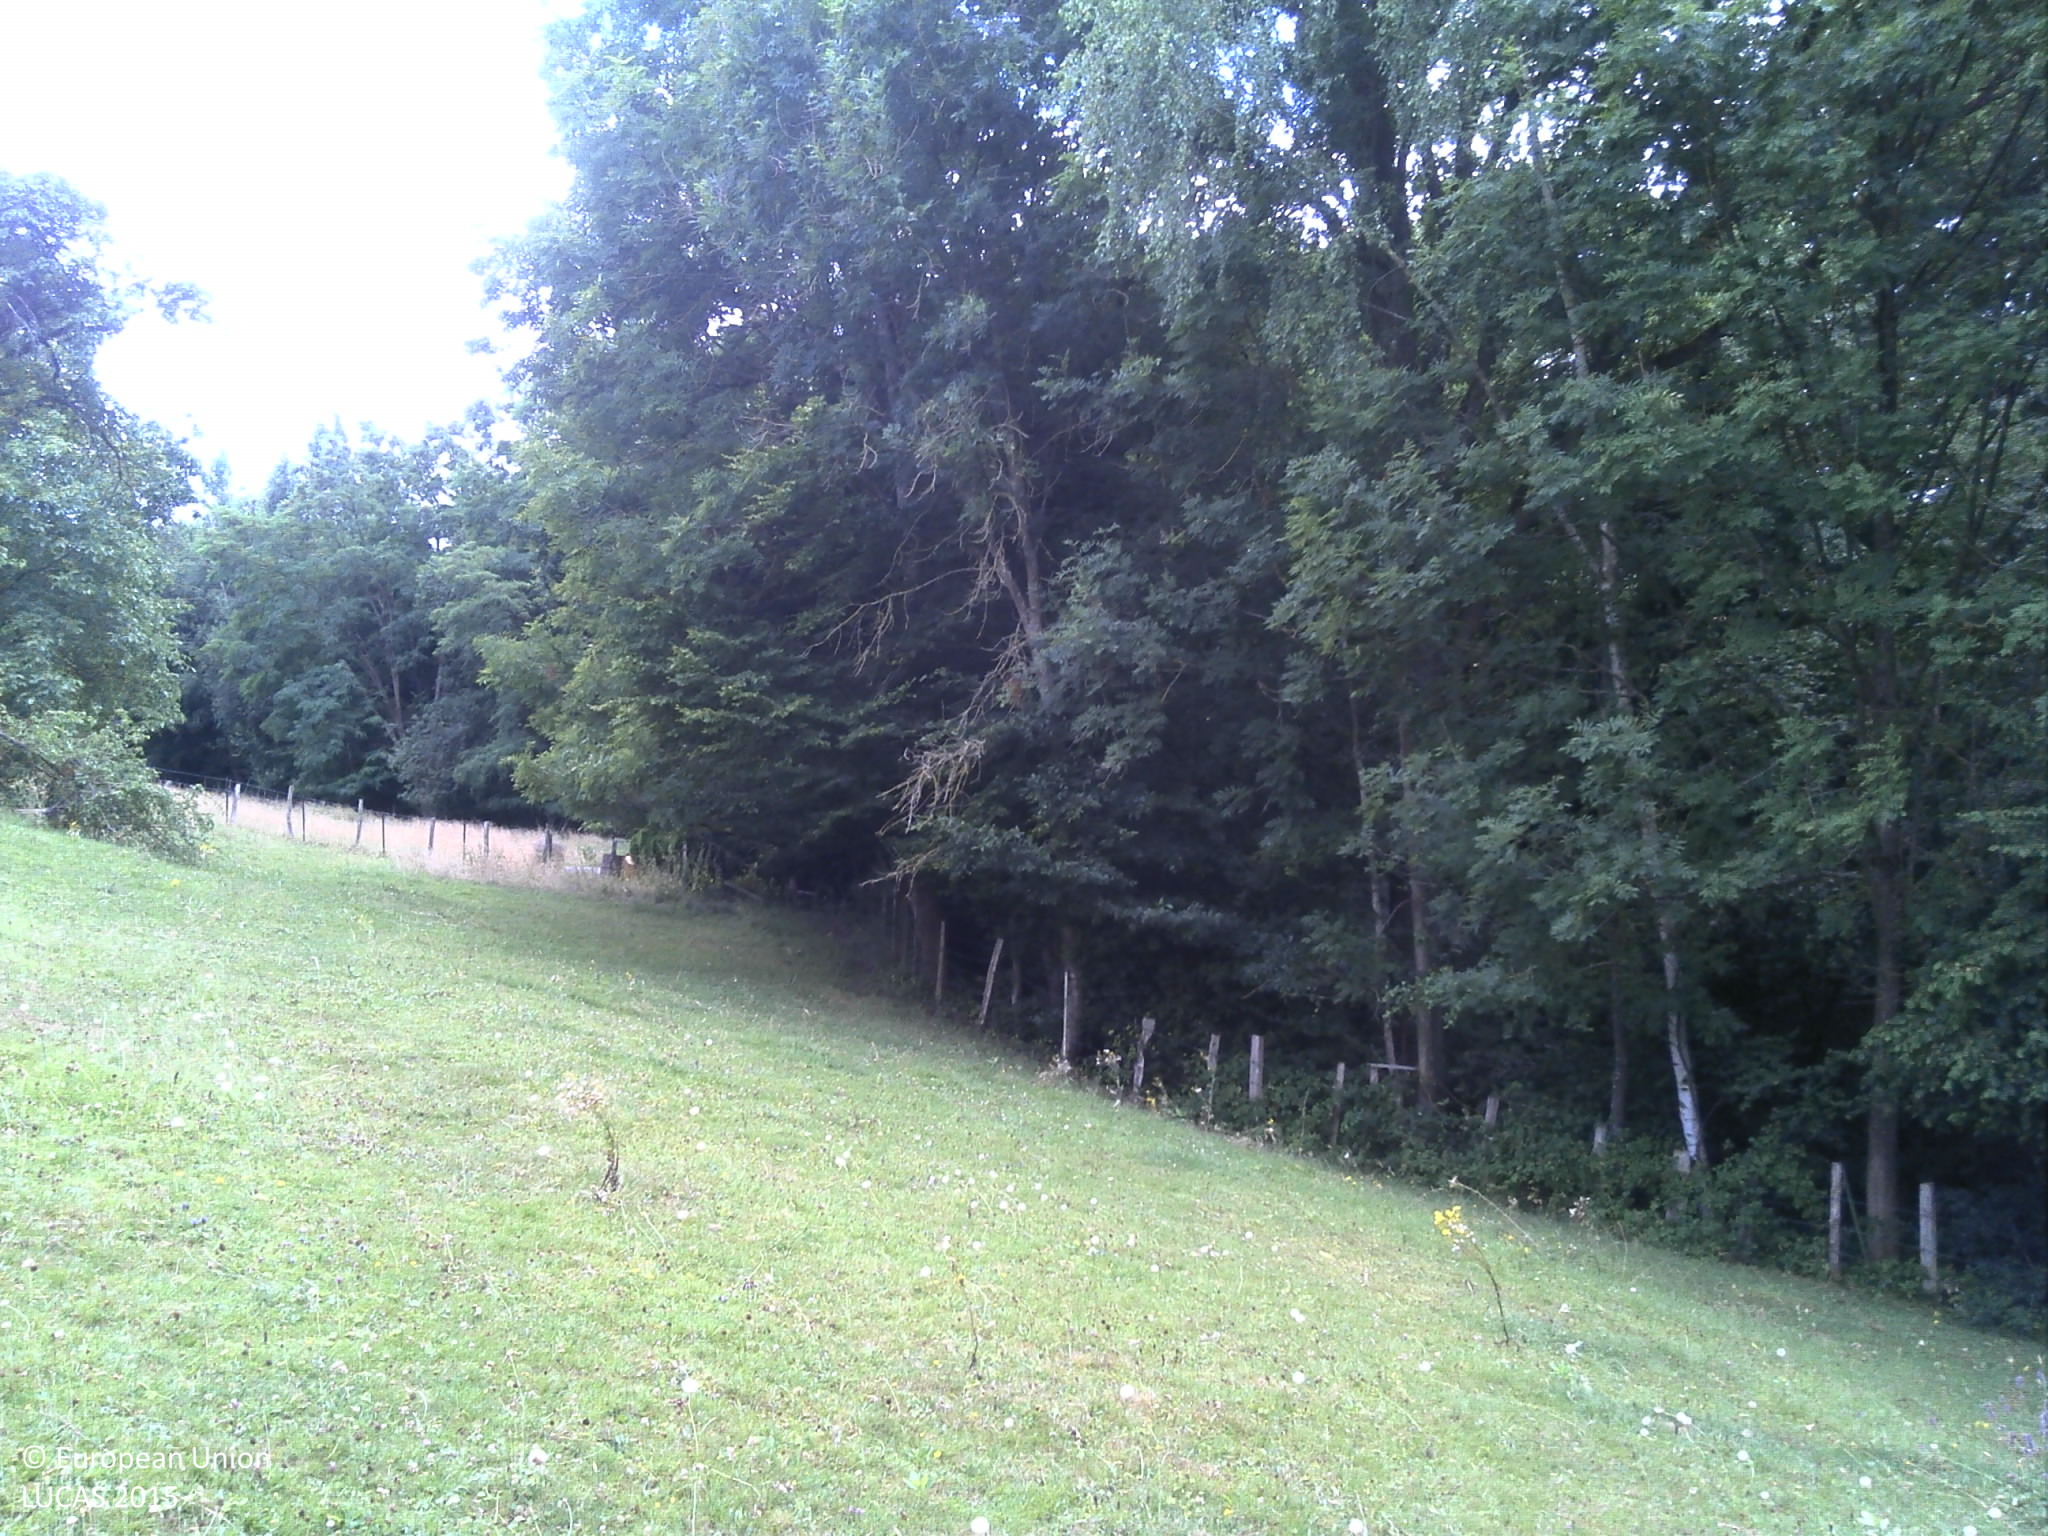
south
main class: Grassland
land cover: Grassland with sparse tree/shrub cover
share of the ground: > 75 %
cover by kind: herbaceous plants 95 %, broadleaved forest trees 5 %
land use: Agriculture (excluding fallow land and kitchen gardens)
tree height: > 5 m
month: July
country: FR
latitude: 48.7837
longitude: 7.2651
